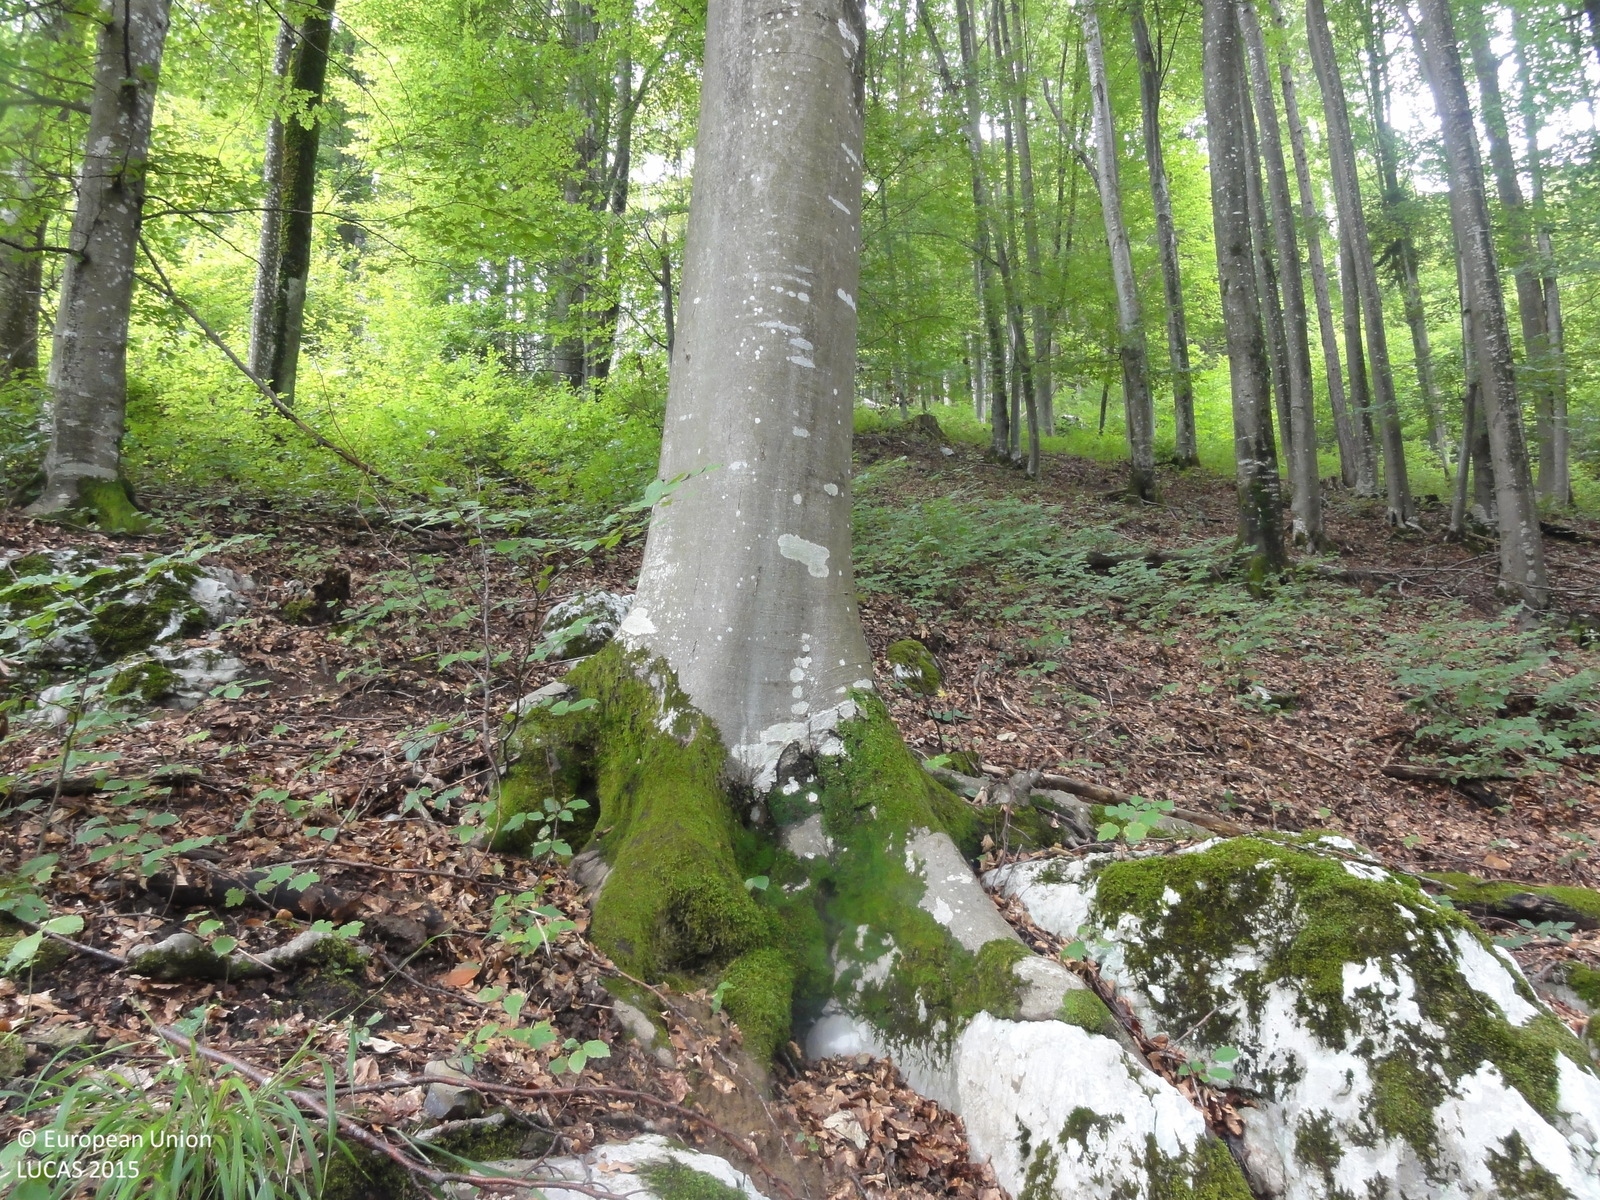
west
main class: Woodland
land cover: Broadleaved woodland
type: beech forest
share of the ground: > 75 %
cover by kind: broadleaved forest trees 95 %, shrubs 5 %
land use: Forestry
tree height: > 5 m
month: August
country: SI
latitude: 45.7640
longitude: 15.0237
